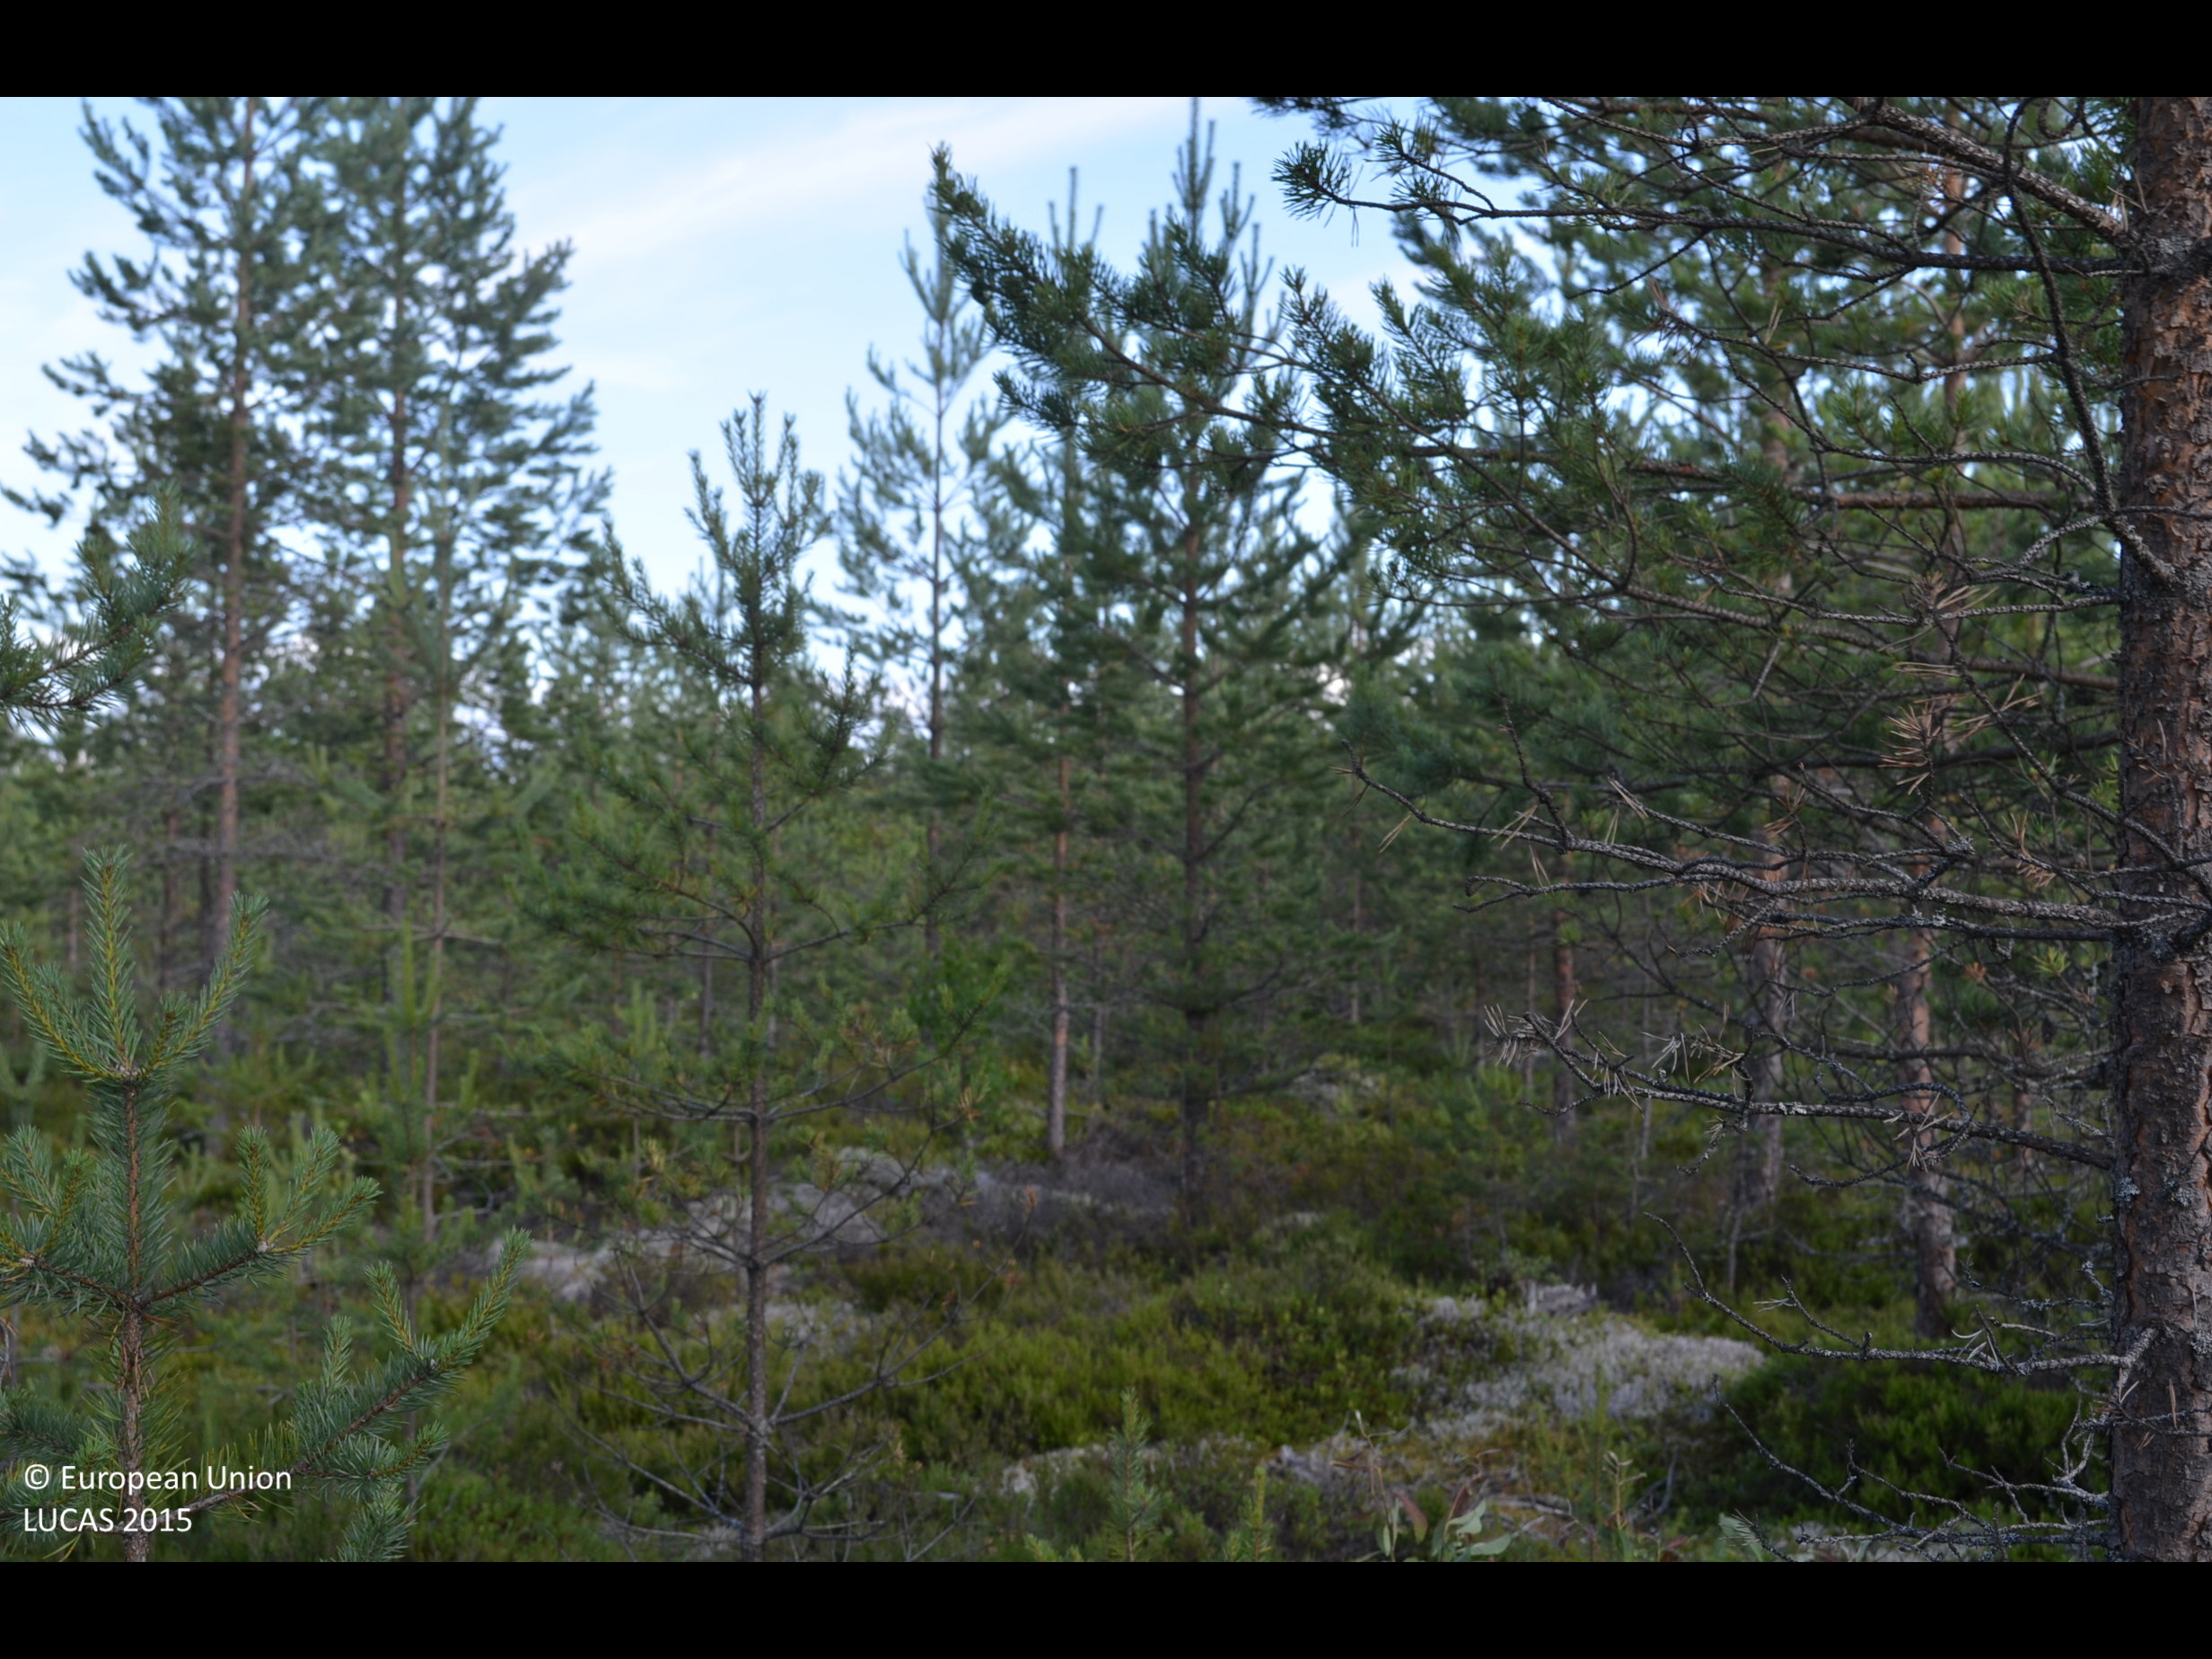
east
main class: Woodland
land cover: Pine dominated coniferous woodland
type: boreal forest
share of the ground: 50 - 75 %
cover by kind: coniferous forest trees 50 %, shrubs 35 %, lichens and mosses 15 %
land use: Forestry
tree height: < 5 m
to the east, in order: Pine dominated coniferous woodland; Ditches and canals; Pine dominated coniferous woodland; Ditches and canals; Pine dominated coniferous woodland; Ditches and canals; Pine dominated coniferous woodland; Shrubland without tree cover; Ditches and canals; Shrubland without tree cover; Ditches and canals
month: July
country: FI
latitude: 62.3392
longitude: 23.6098
